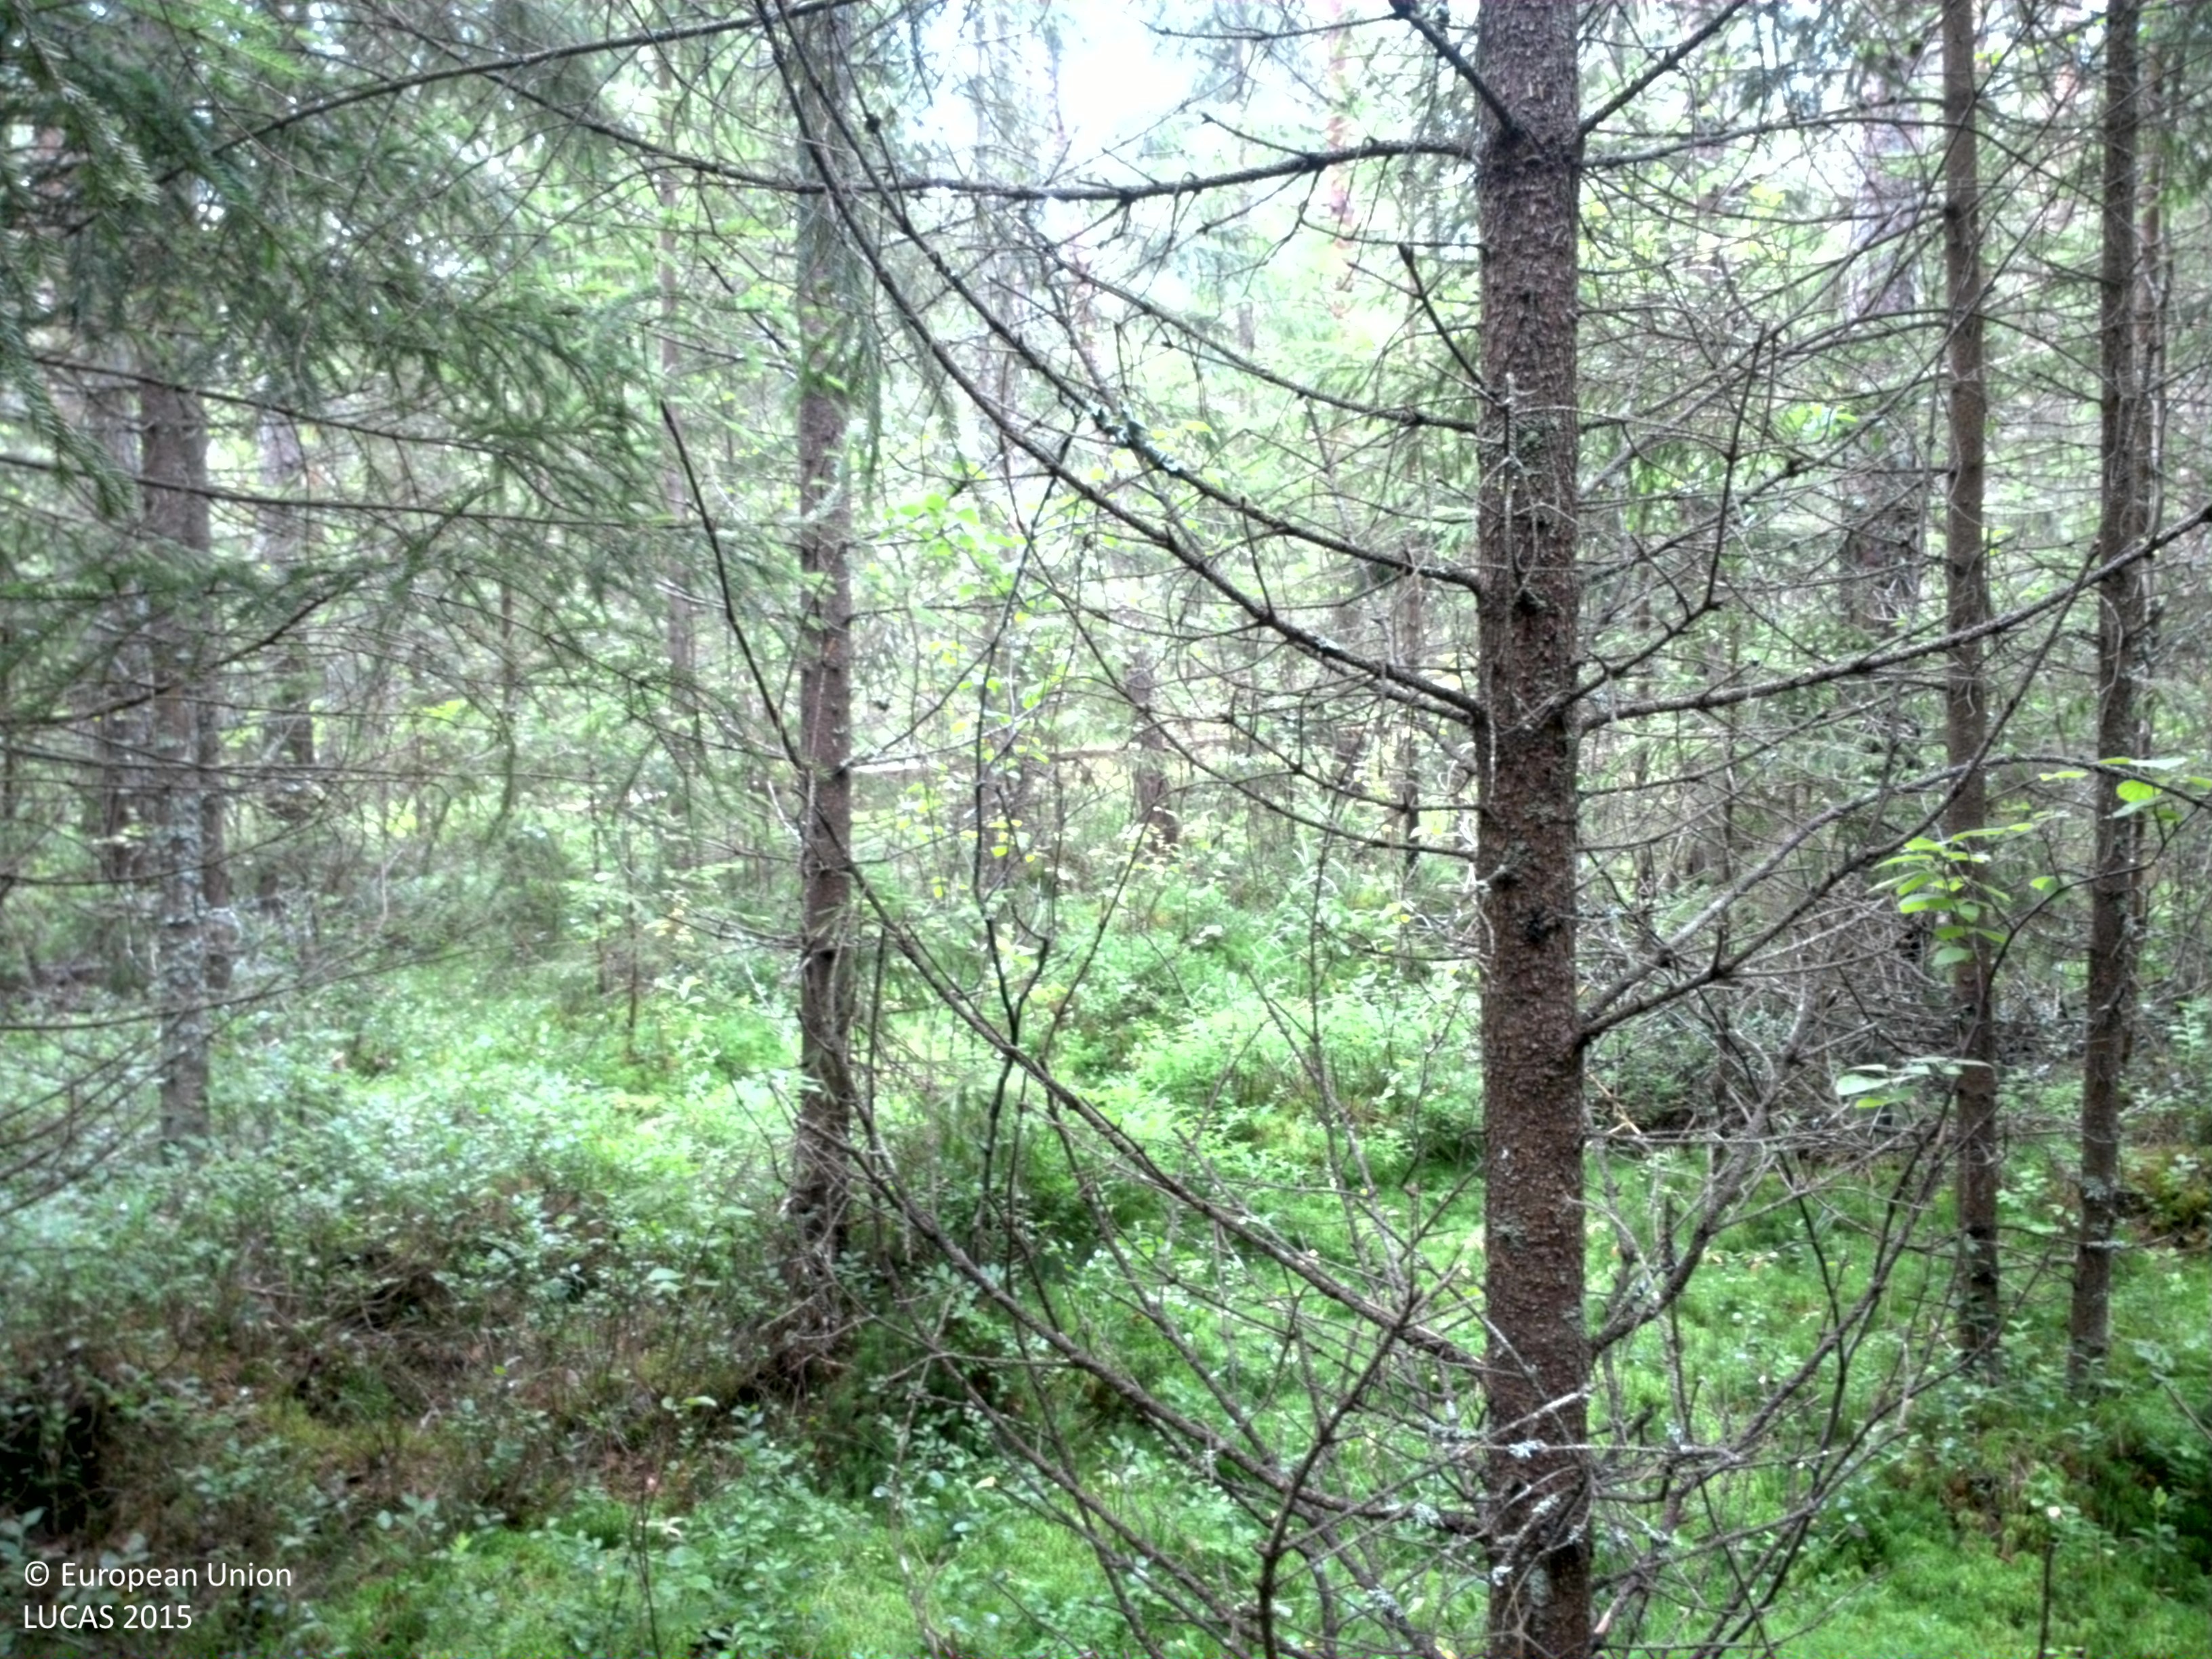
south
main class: Woodland
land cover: Other coniferous woodland
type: boreal forest
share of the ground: 50 - 75 %
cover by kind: coniferous forest trees 65 %, lichens and mosses 25 %, broadleaved forest trees 5 %, shrubs 5 %
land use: Forestry
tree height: > 5 m
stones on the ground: < 10 %
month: August
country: SE
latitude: 59.6203
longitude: 13.2716
